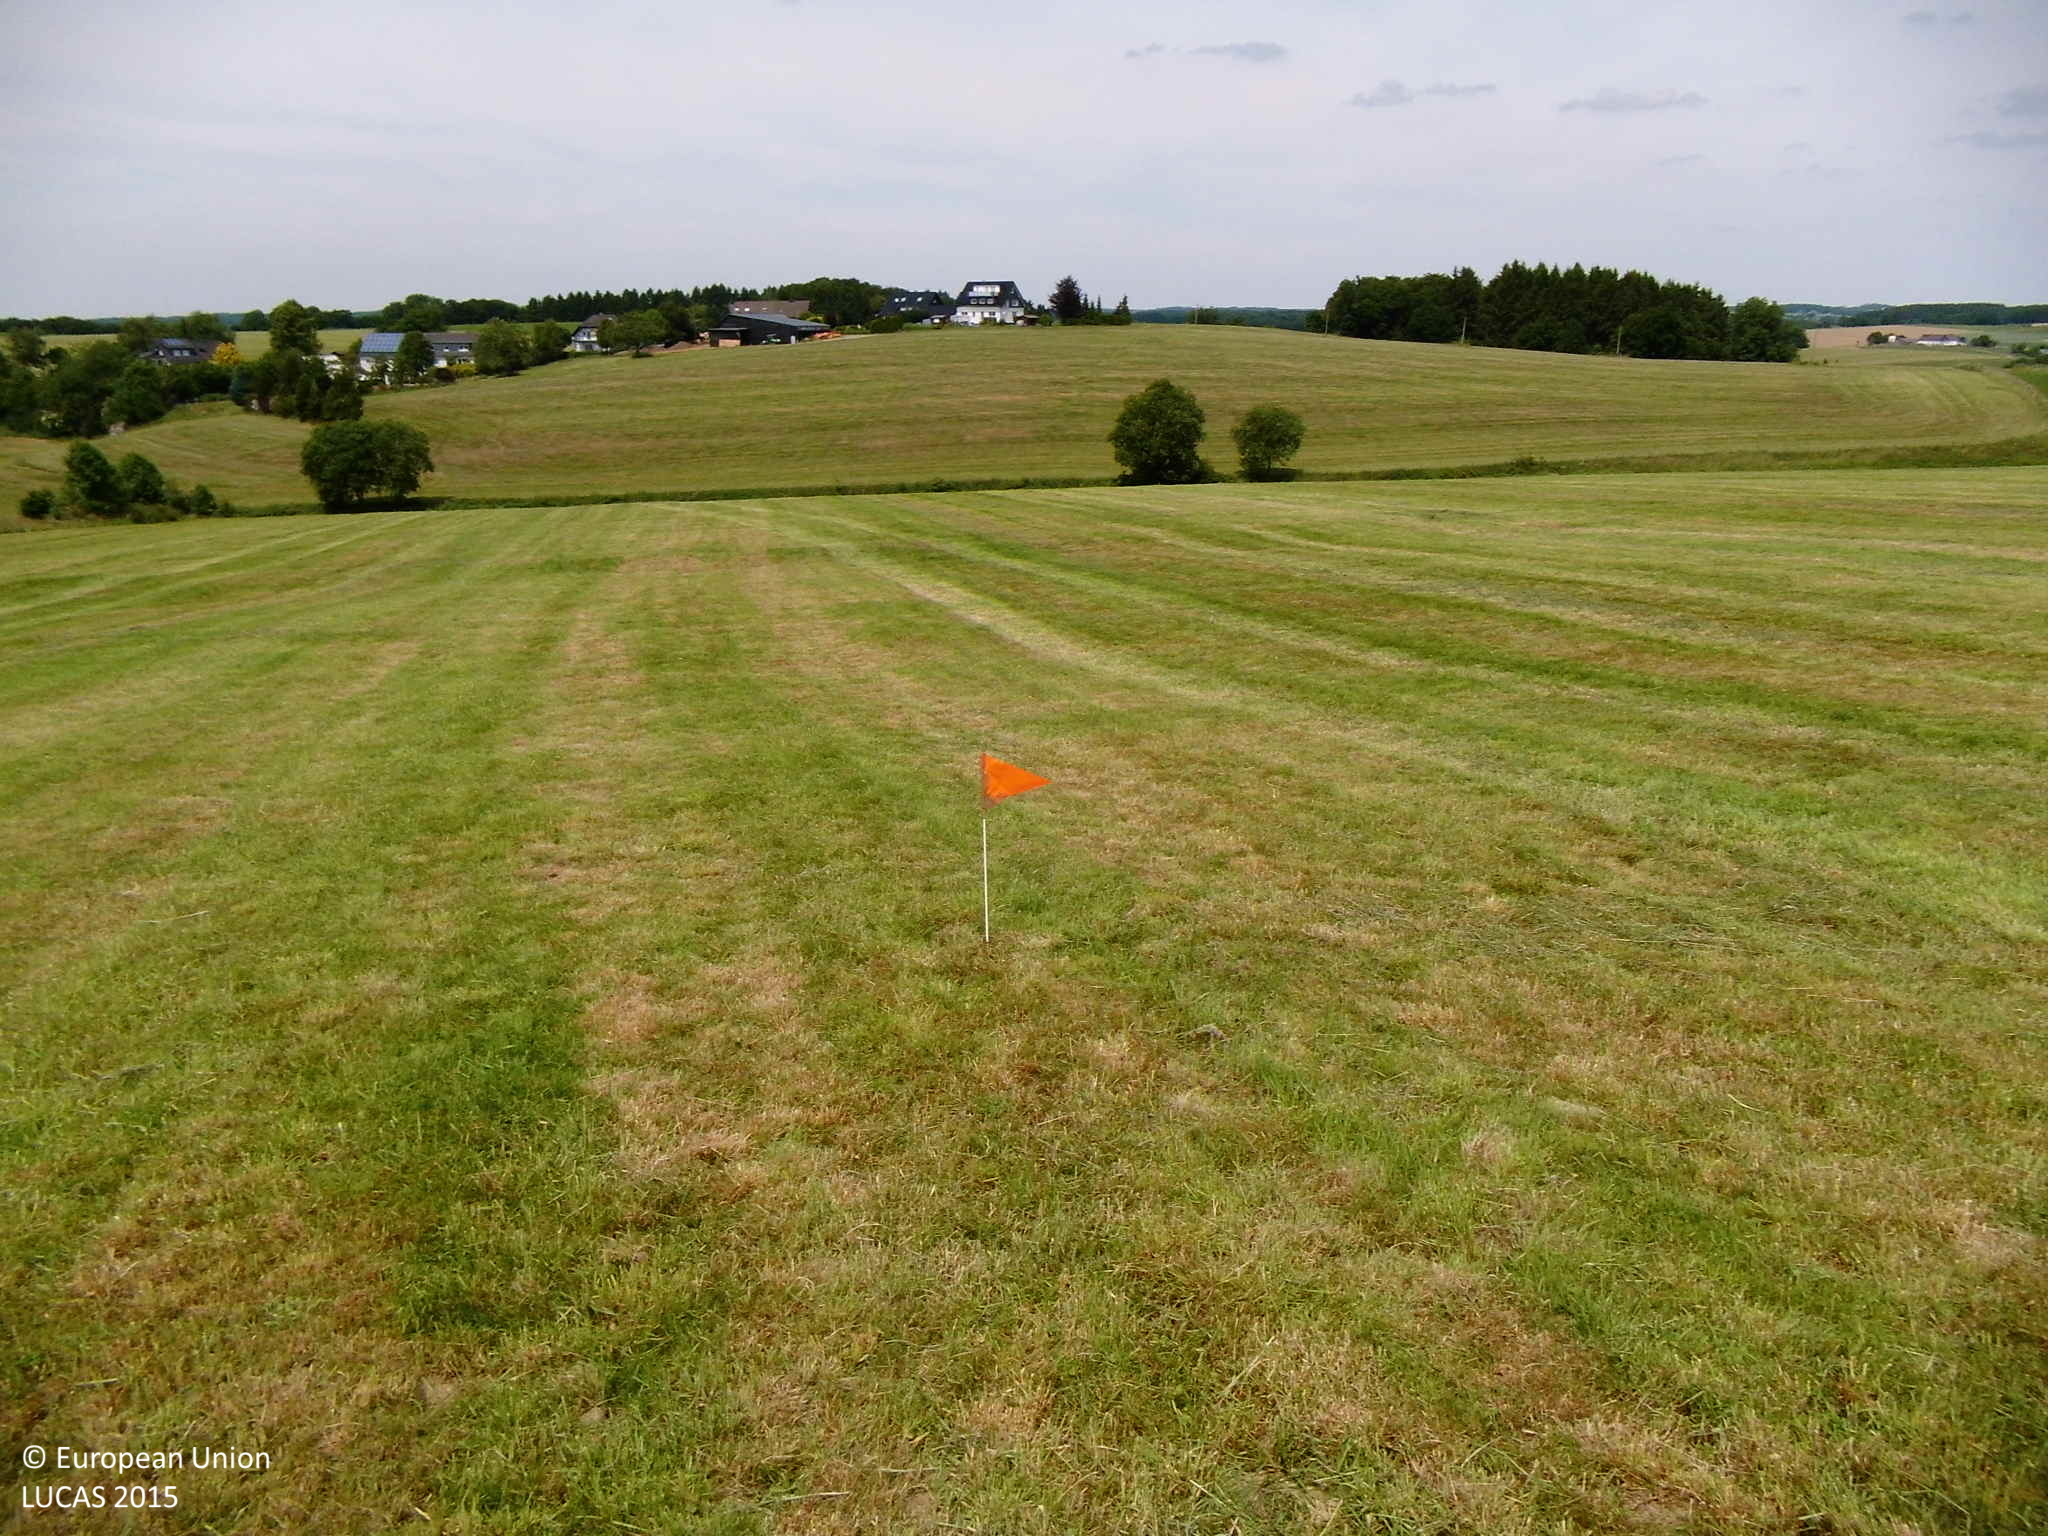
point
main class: Grassland
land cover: Grassland without tree/shrub cover
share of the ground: > 75 %
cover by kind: herbaceous plants 100 %
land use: Agriculture (excluding fallow land and kitchen gardens)
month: June
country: DE
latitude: 51.1090
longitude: 7.4435
